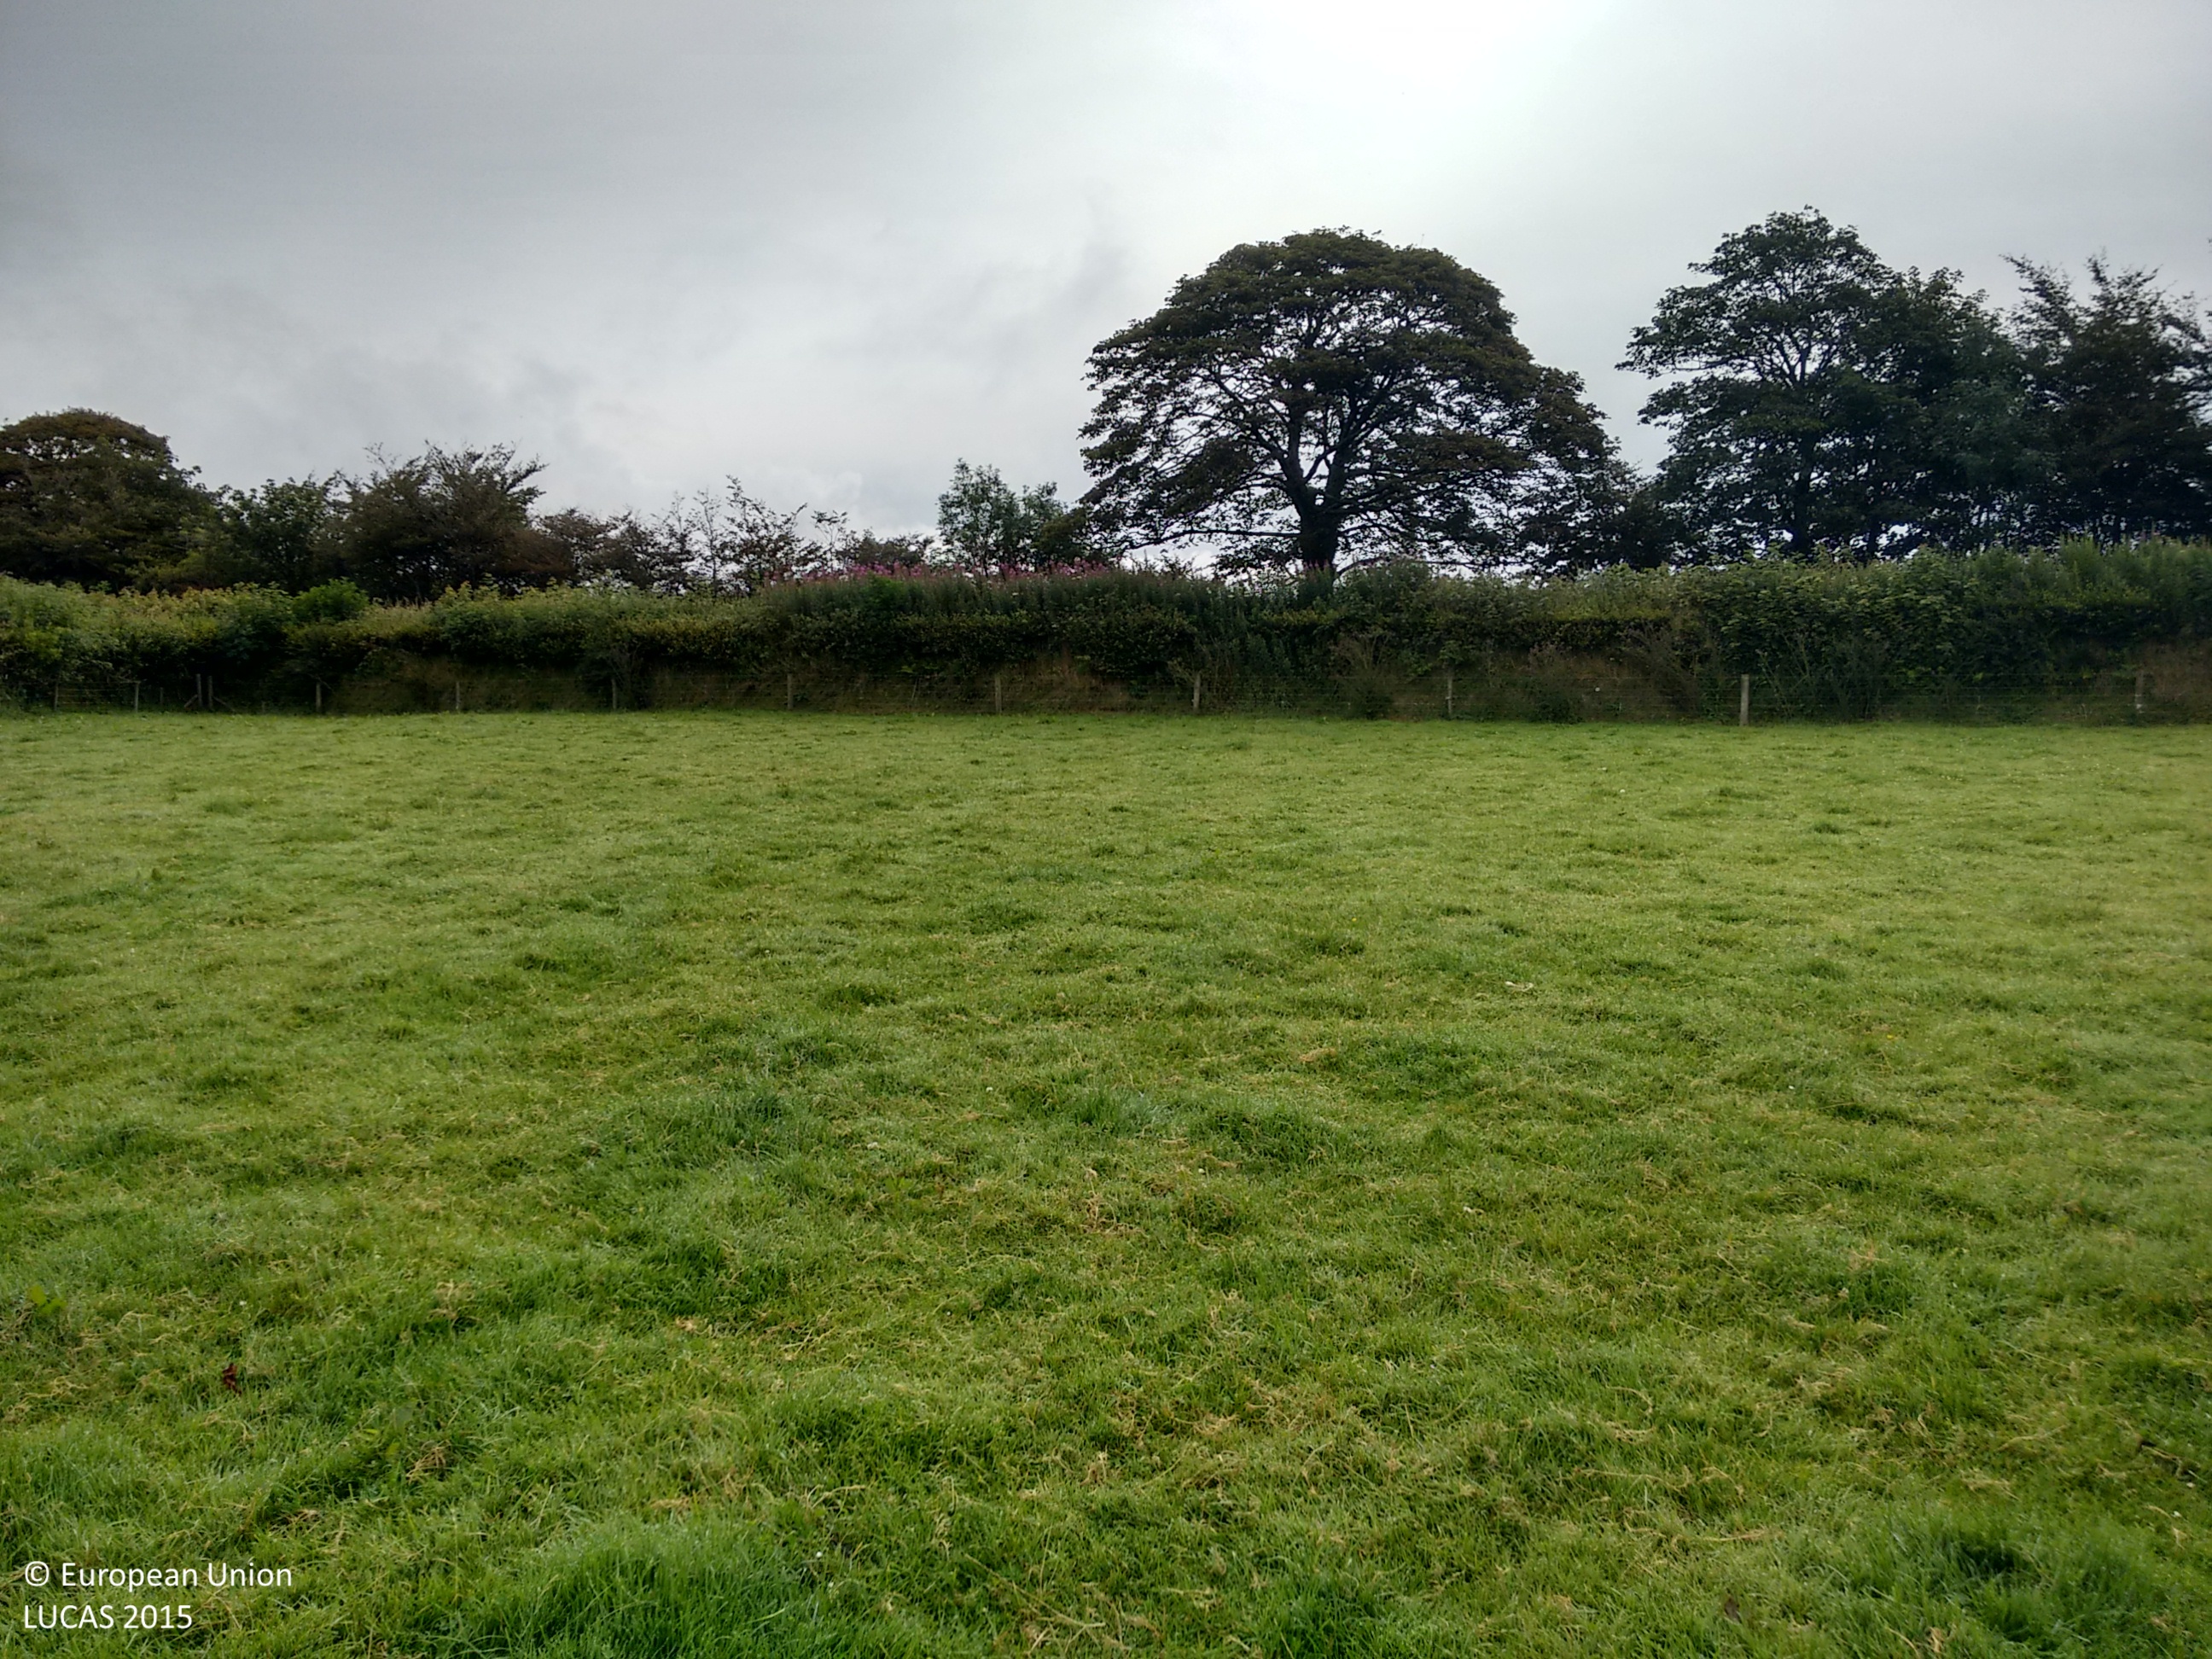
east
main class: Grassland
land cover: Grassland without tree/shrub cover
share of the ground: > 75 %
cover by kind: herbaceous plants 100 %
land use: Agriculture (excluding fallow land and kitchen gardens)
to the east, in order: Grassland without tree/shrub cover; Fences; Dry stone walls; Grass margins; Paved roads, cycling and walking lanes; Managed hedges; Grassland without tree/shrub cover; Fences; Managed hedges; Grassland without tree/shrub cover
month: August
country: GB
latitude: 51.0871
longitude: -3.8393
